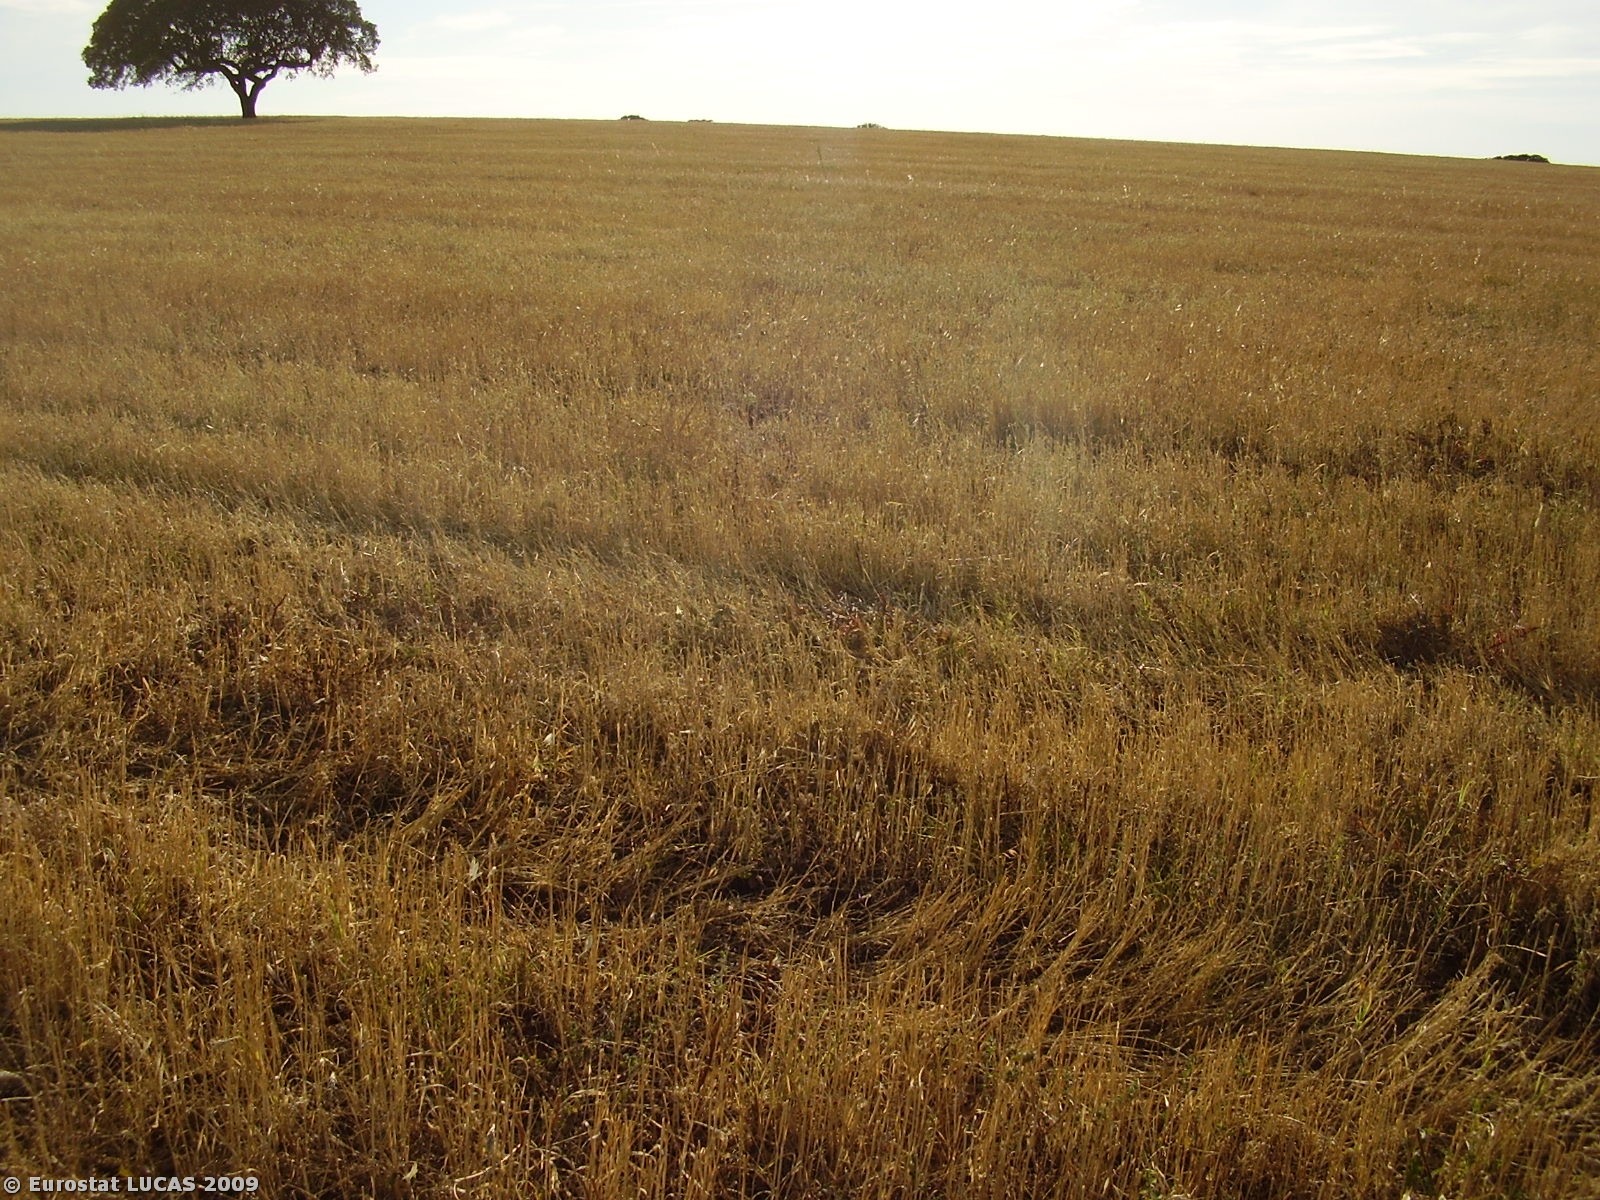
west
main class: Cropland
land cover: Triticale
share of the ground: > 75 %
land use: Agriculture (excluding fallow land and kitchen gardens)
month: July
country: PT
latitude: 38.4685
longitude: -7.6475
